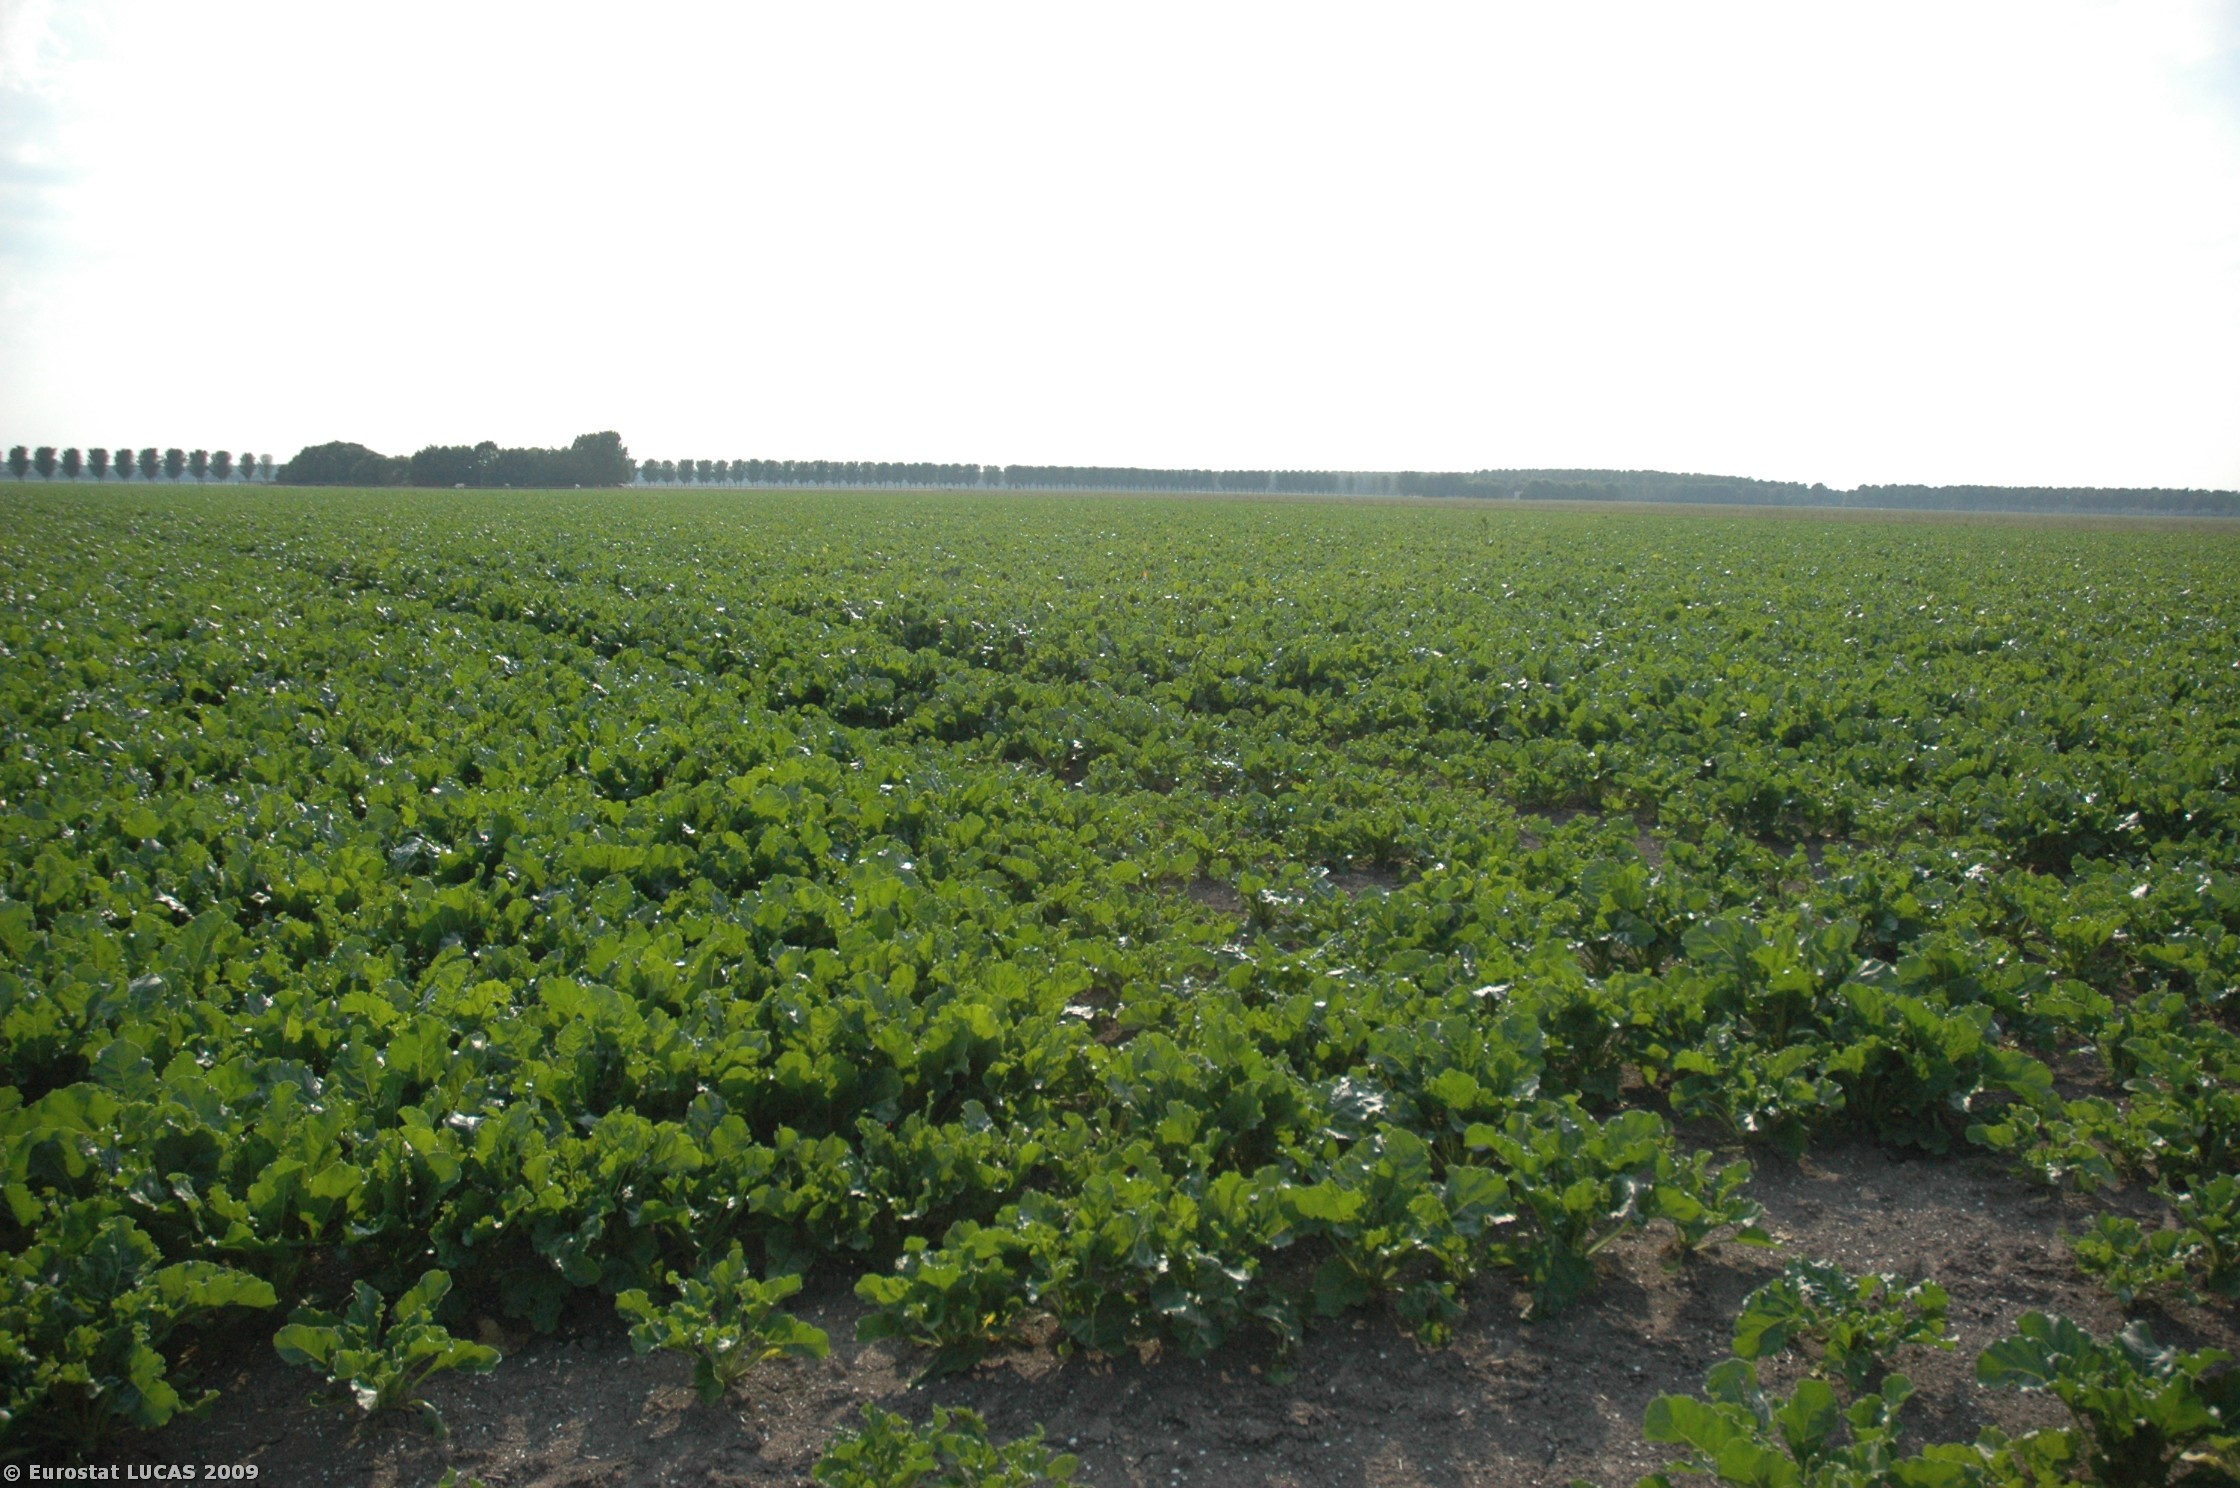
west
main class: Grassland
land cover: Grassland without tree/shrub cover
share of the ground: > 75 %
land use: Agriculture (excluding fallow land and kitchen gardens)
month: June
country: NL
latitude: 52.3403
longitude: 5.3453
